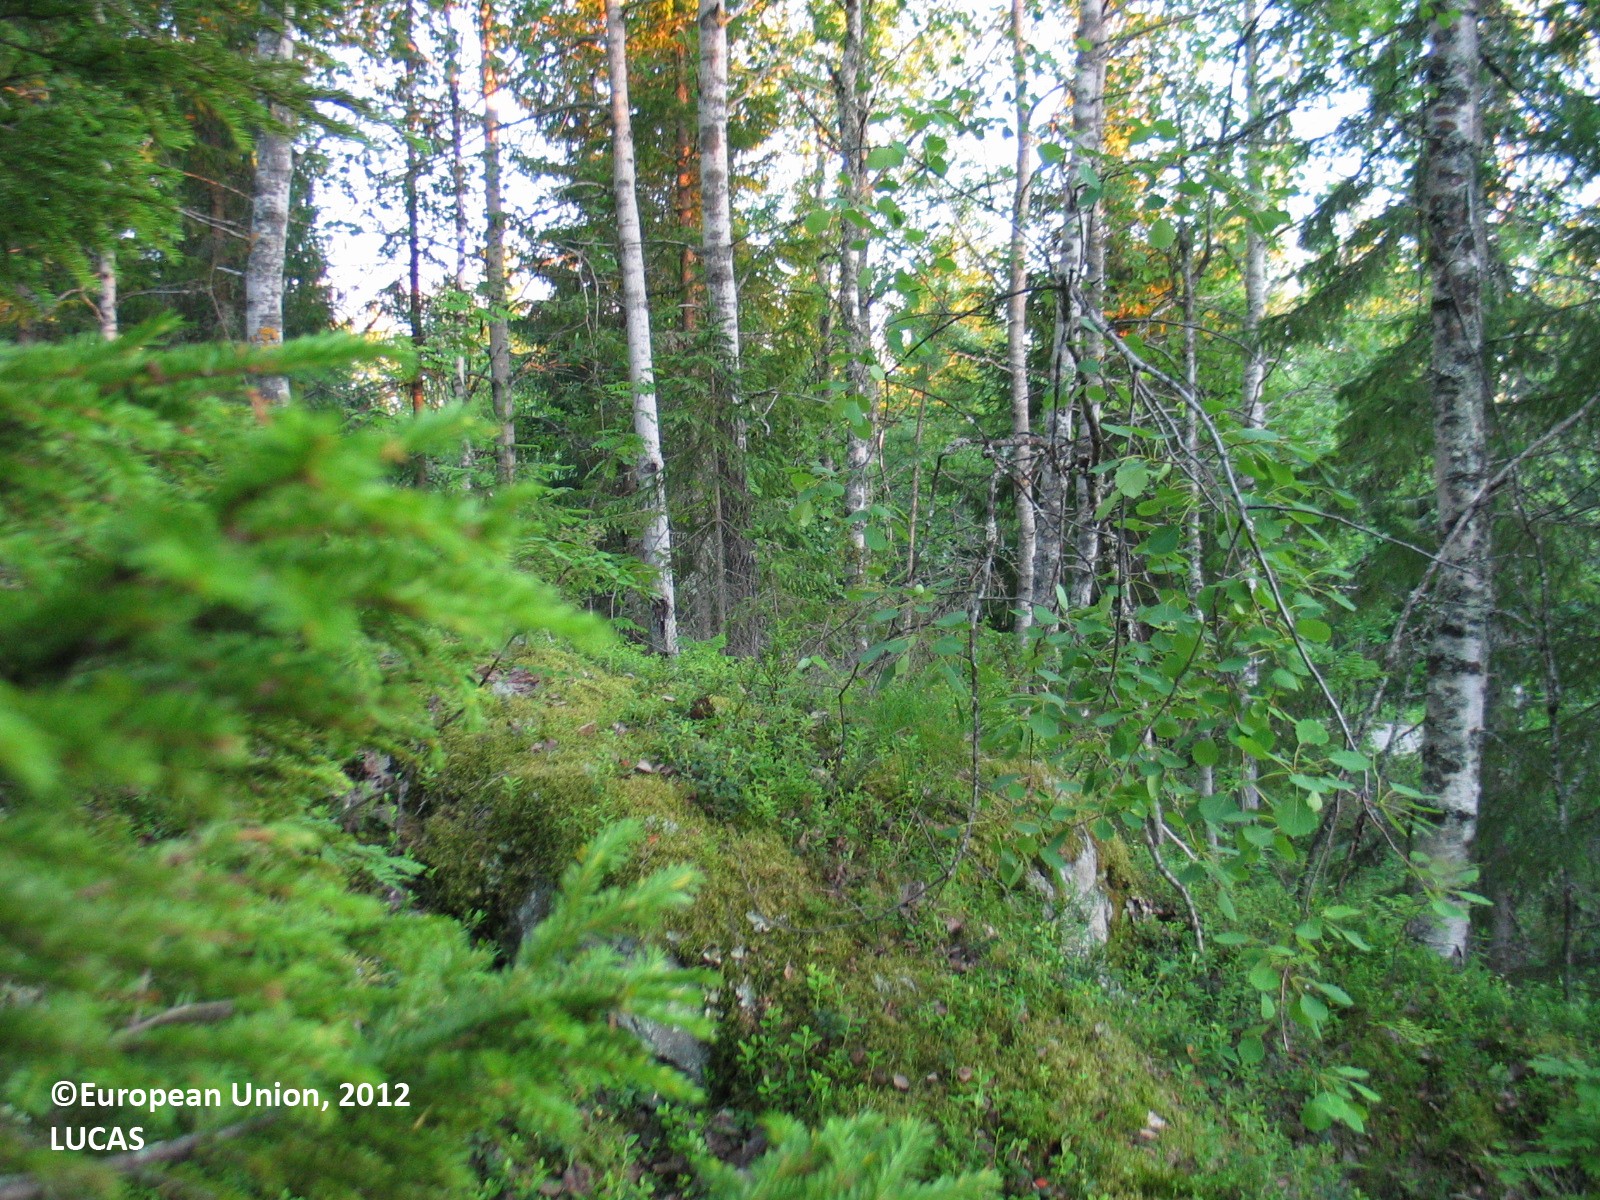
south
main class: Woodland
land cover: Other mixed woodland
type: boreal forest
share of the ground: 25 - 50 %
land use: Forestry
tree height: > 5 m
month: July
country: FI
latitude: 65.8960
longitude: 25.0059
